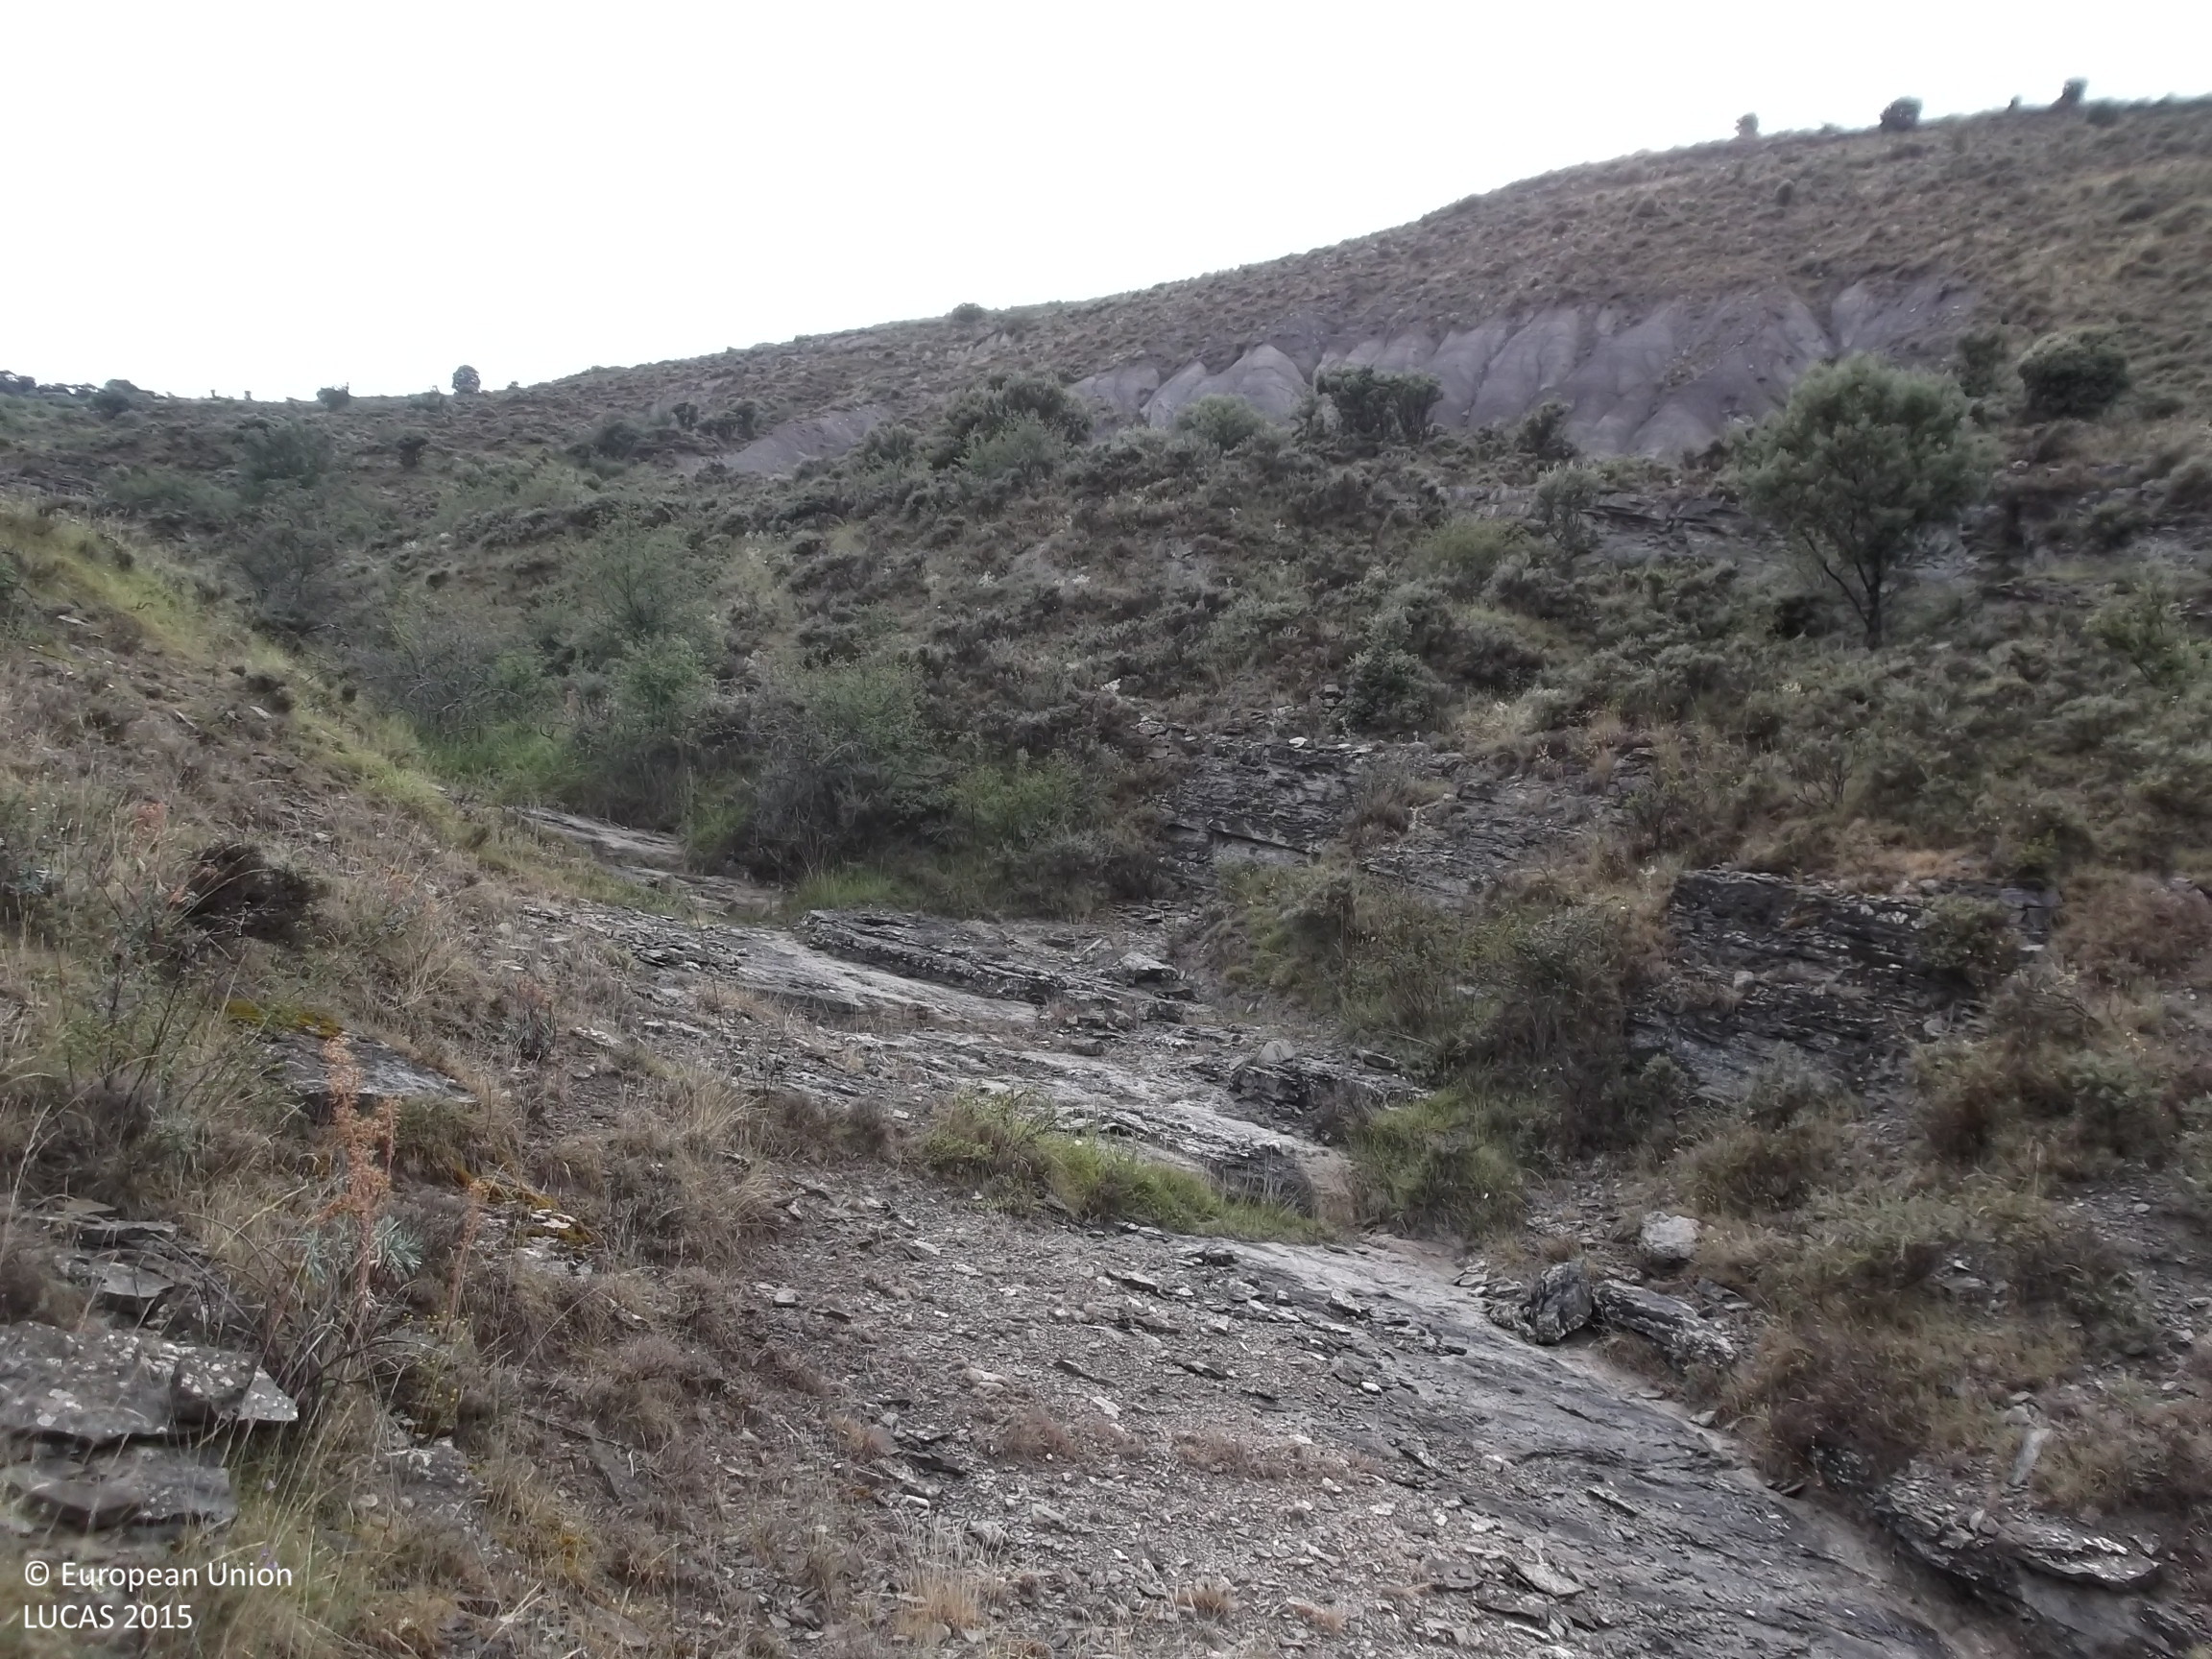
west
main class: Shrubland
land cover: Shrubland with sparse tree cover
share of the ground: 50 - 75 %
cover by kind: shrubs 60 %, herbaceous plants 20 %, unconsolidated bare surface 15 %, broadleaved forest trees 5 %
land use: Semi-natural and natural areas not in use
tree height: < 5 m
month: July
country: ES
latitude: 42.1270
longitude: -2.2449
